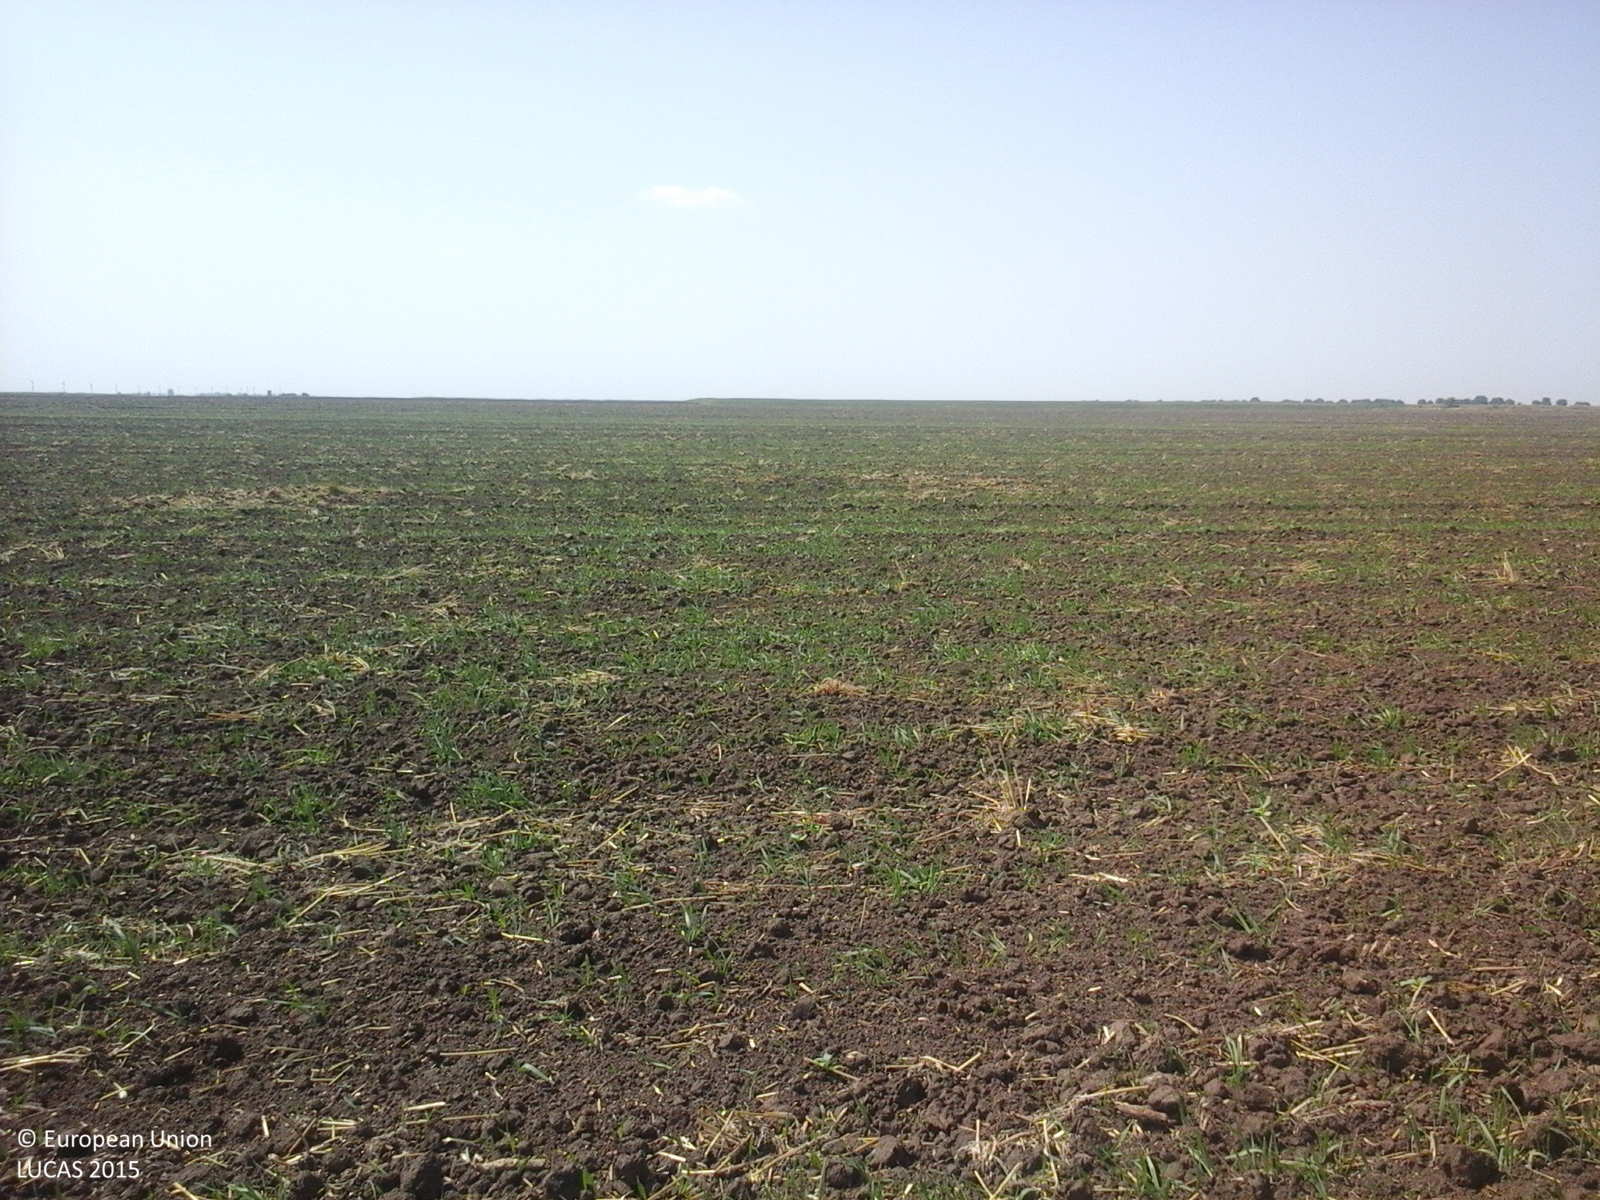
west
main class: Cropland
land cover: Common wheat
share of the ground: 25 - 50 %
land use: Agriculture (excluding fallow land and kitchen gardens)
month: July
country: RO
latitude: 44.7071
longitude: 27.1883
